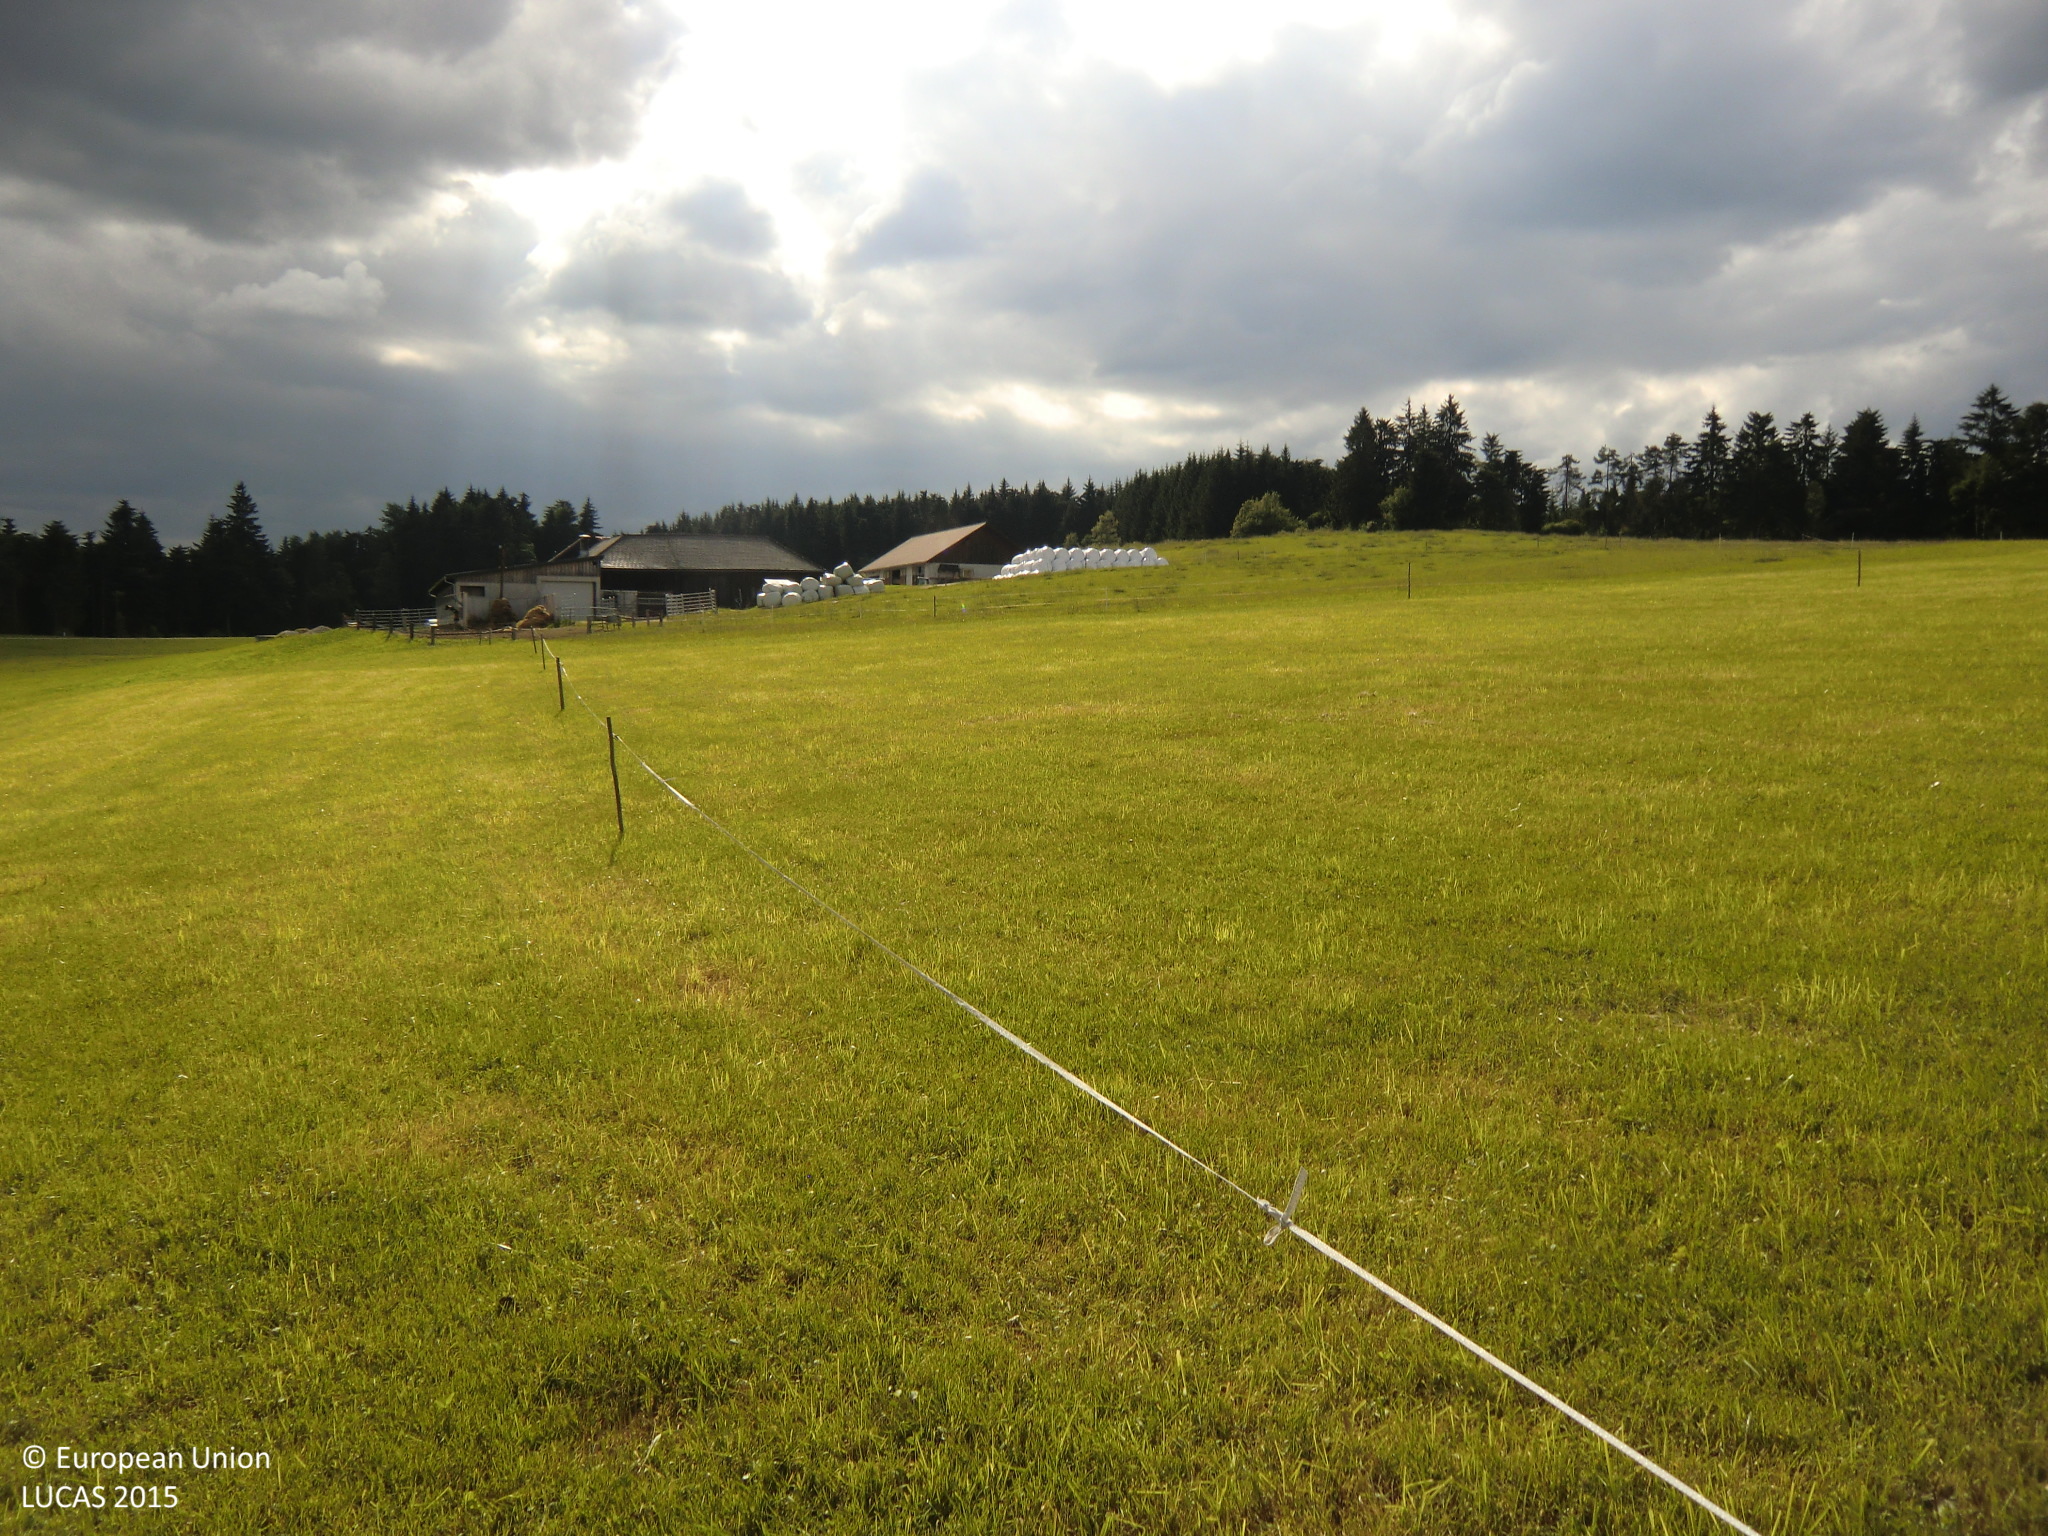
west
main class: Grassland
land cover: Grassland without tree/shrub cover
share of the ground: > 75 %
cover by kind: herbaceous plants 100 %
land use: Agriculture (excluding fallow land and kitchen gardens)
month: June
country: AT
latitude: 48.5141
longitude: 14.8342
